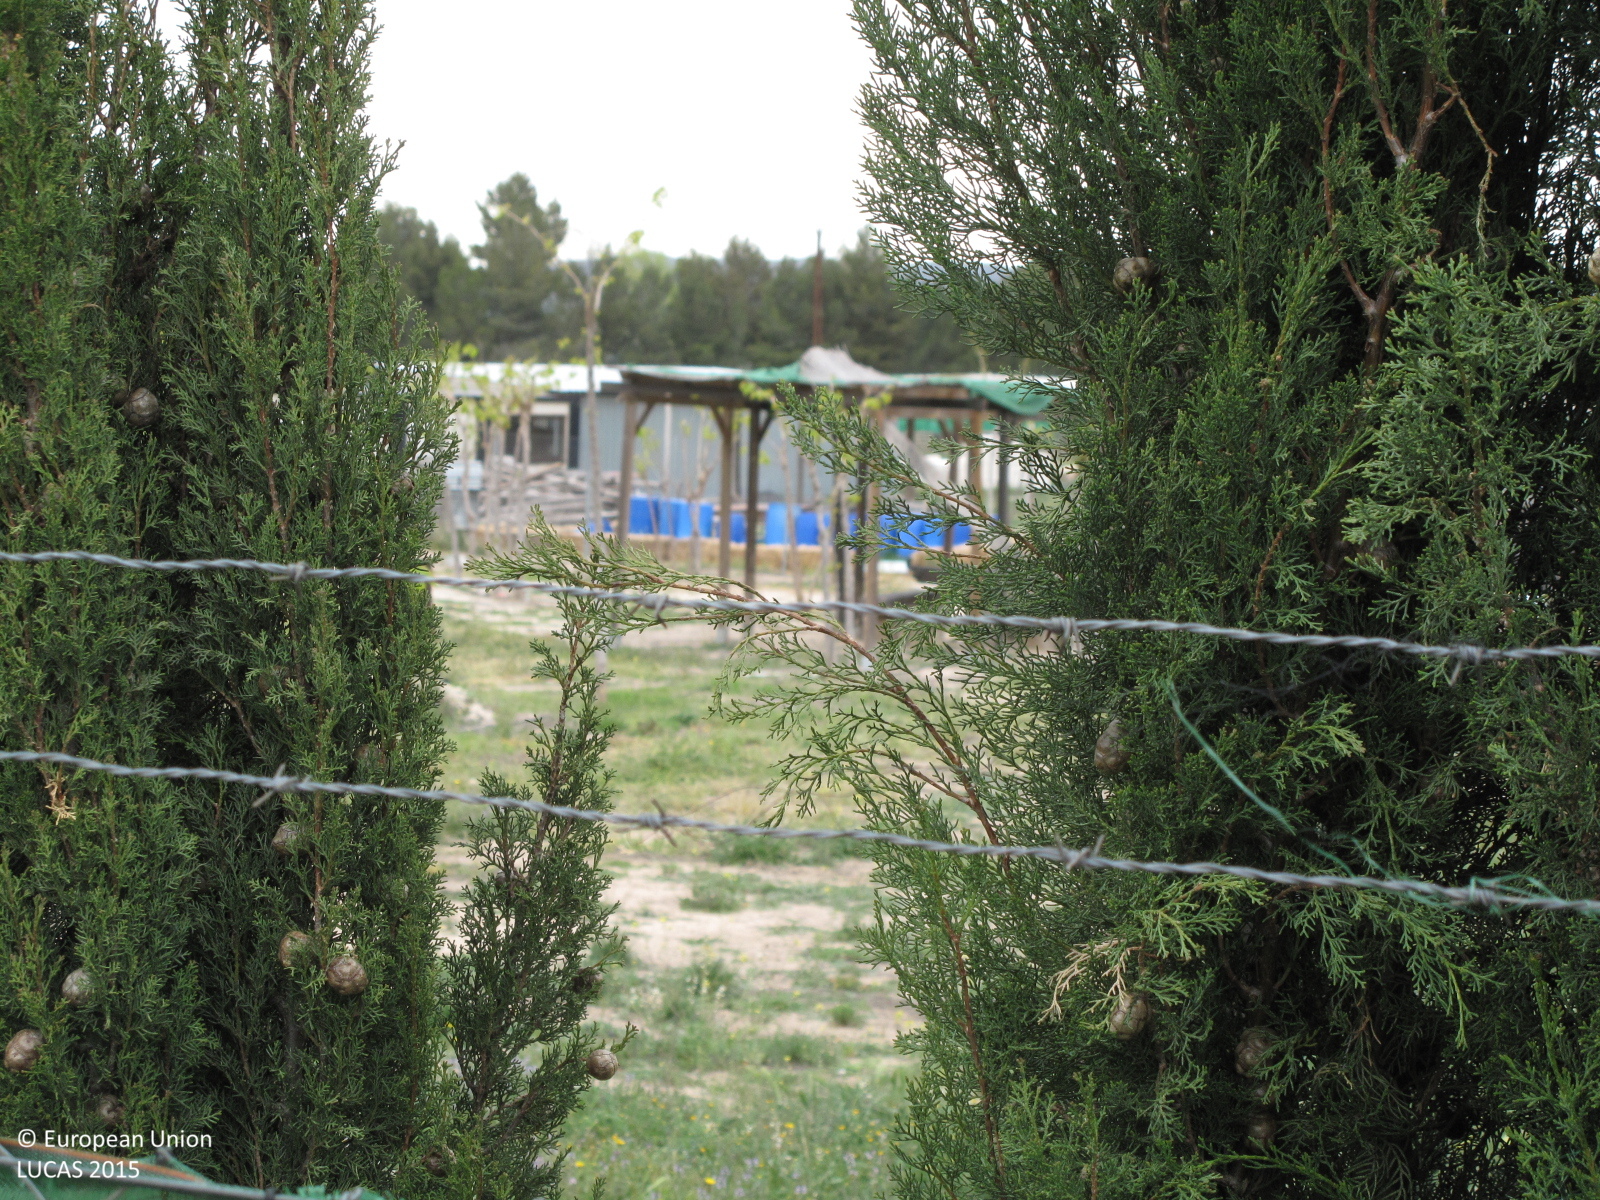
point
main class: Grassland
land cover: Spontaneously vegetated surfaces
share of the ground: 10 - 25 %
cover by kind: consolidated bare surface 75 %, herbaceous plants 25 %
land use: Residential
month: April
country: ES
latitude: 38.6316
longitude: -0.9380
